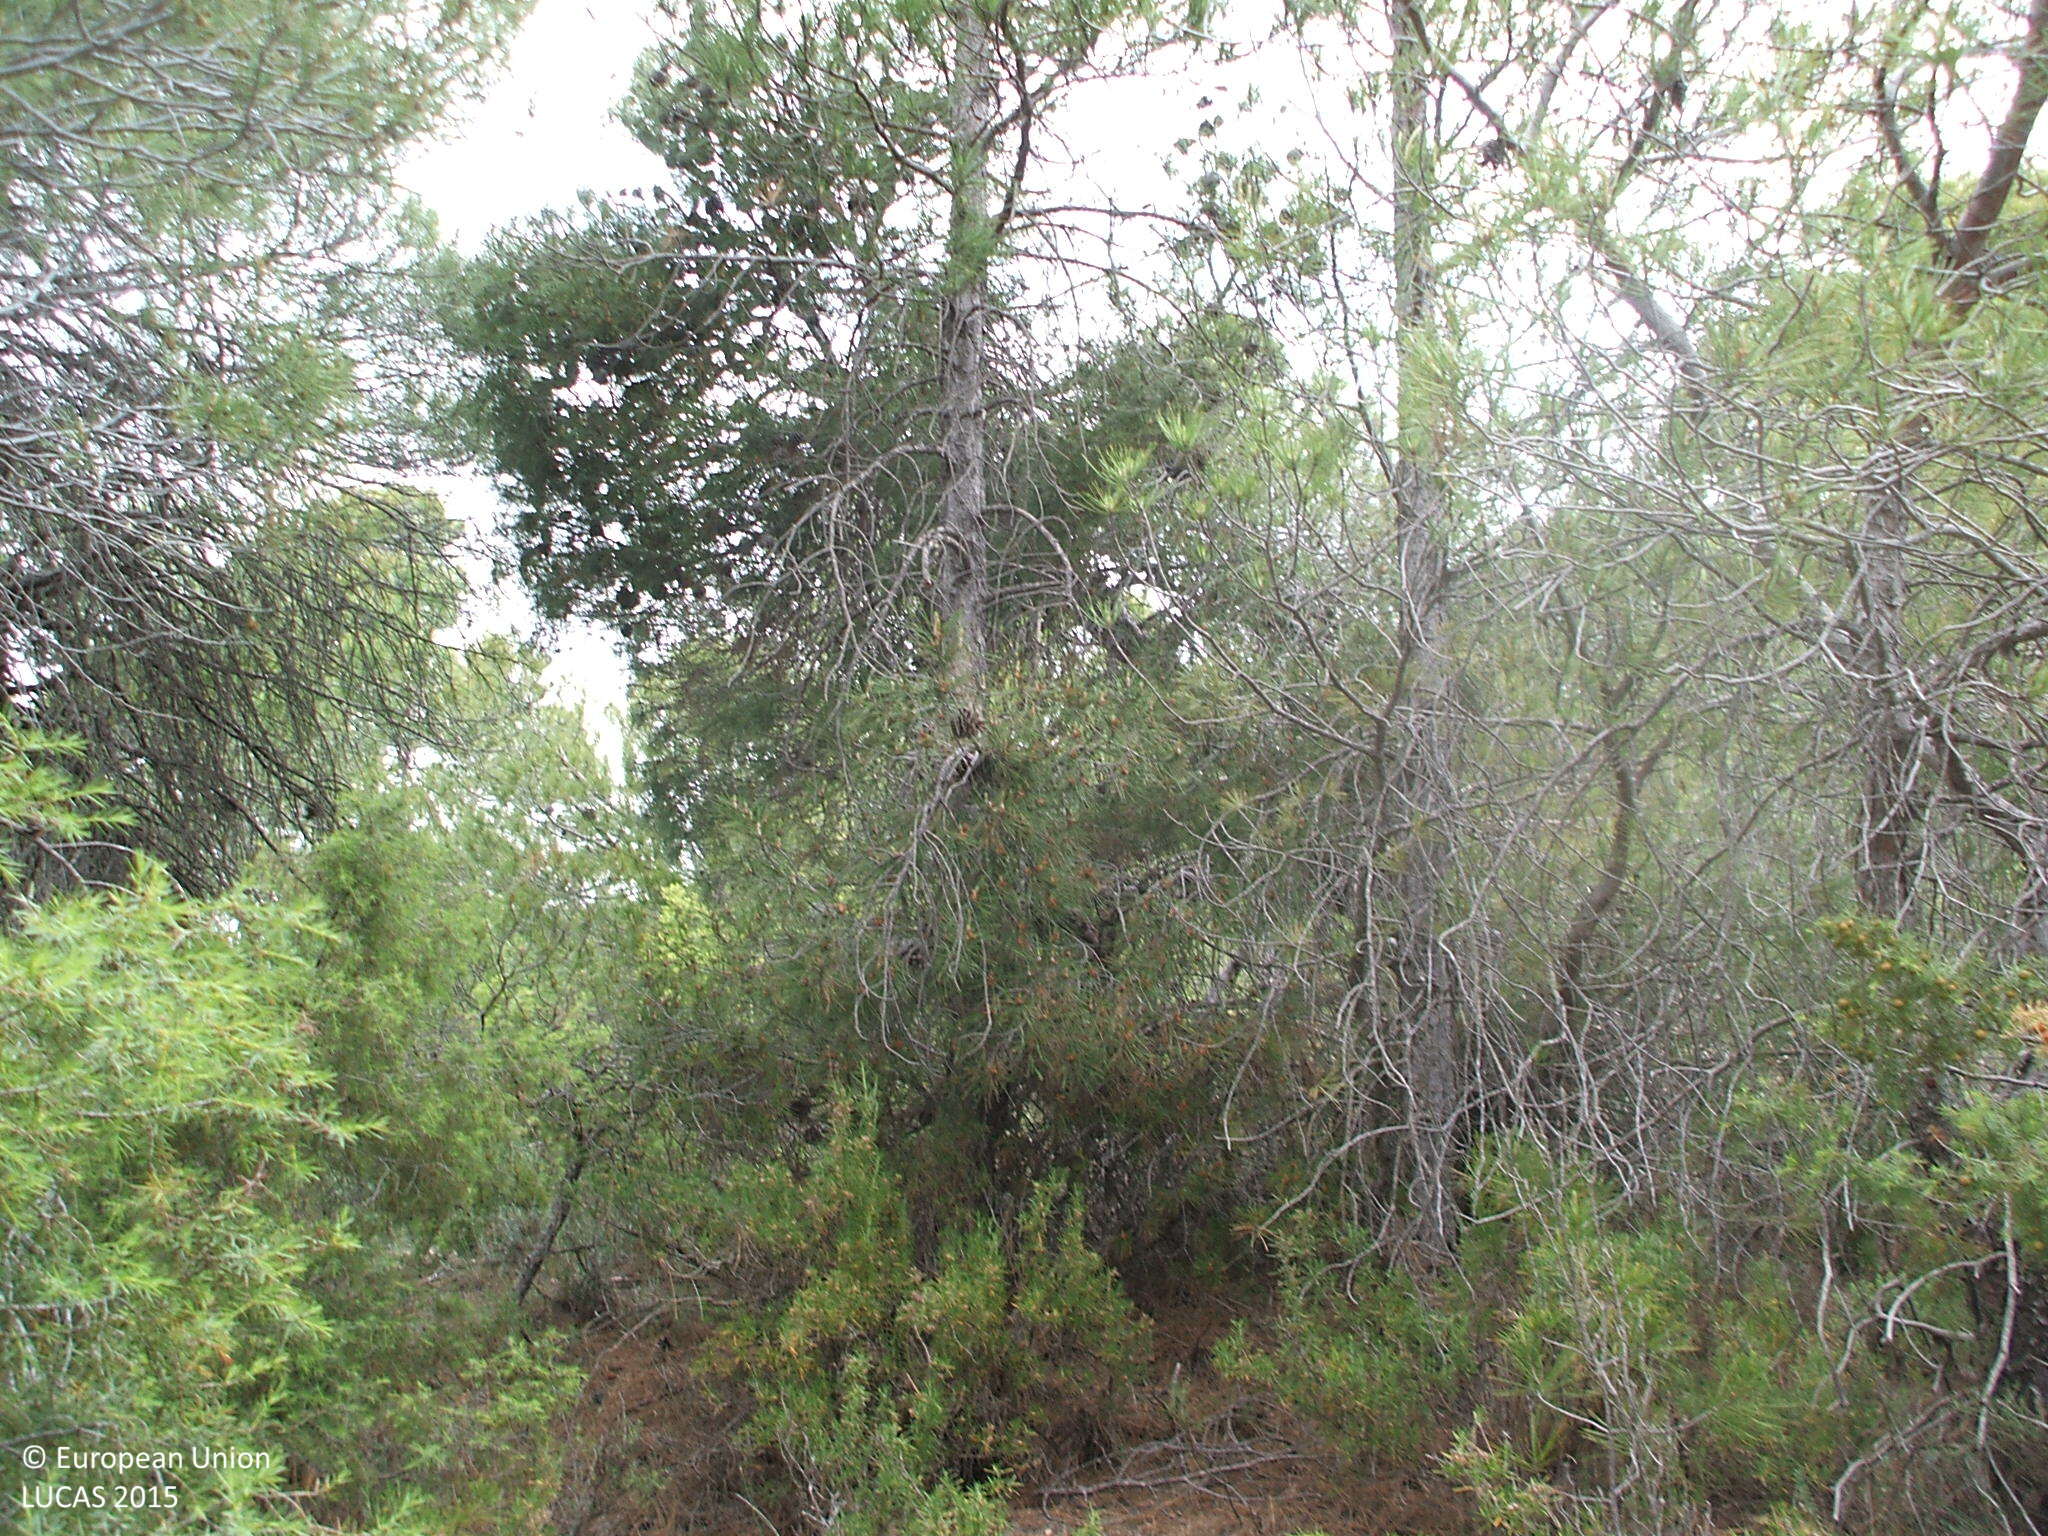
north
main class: Woodland
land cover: Pine dominated coniferous woodland
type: coniferous forest of the mediterranean region
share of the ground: > 75 %
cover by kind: coniferous forest trees 100 %
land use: Semi-natural and natural areas not in use
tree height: > 5 m
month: June
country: ES
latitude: 40.8268
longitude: -0.0284
